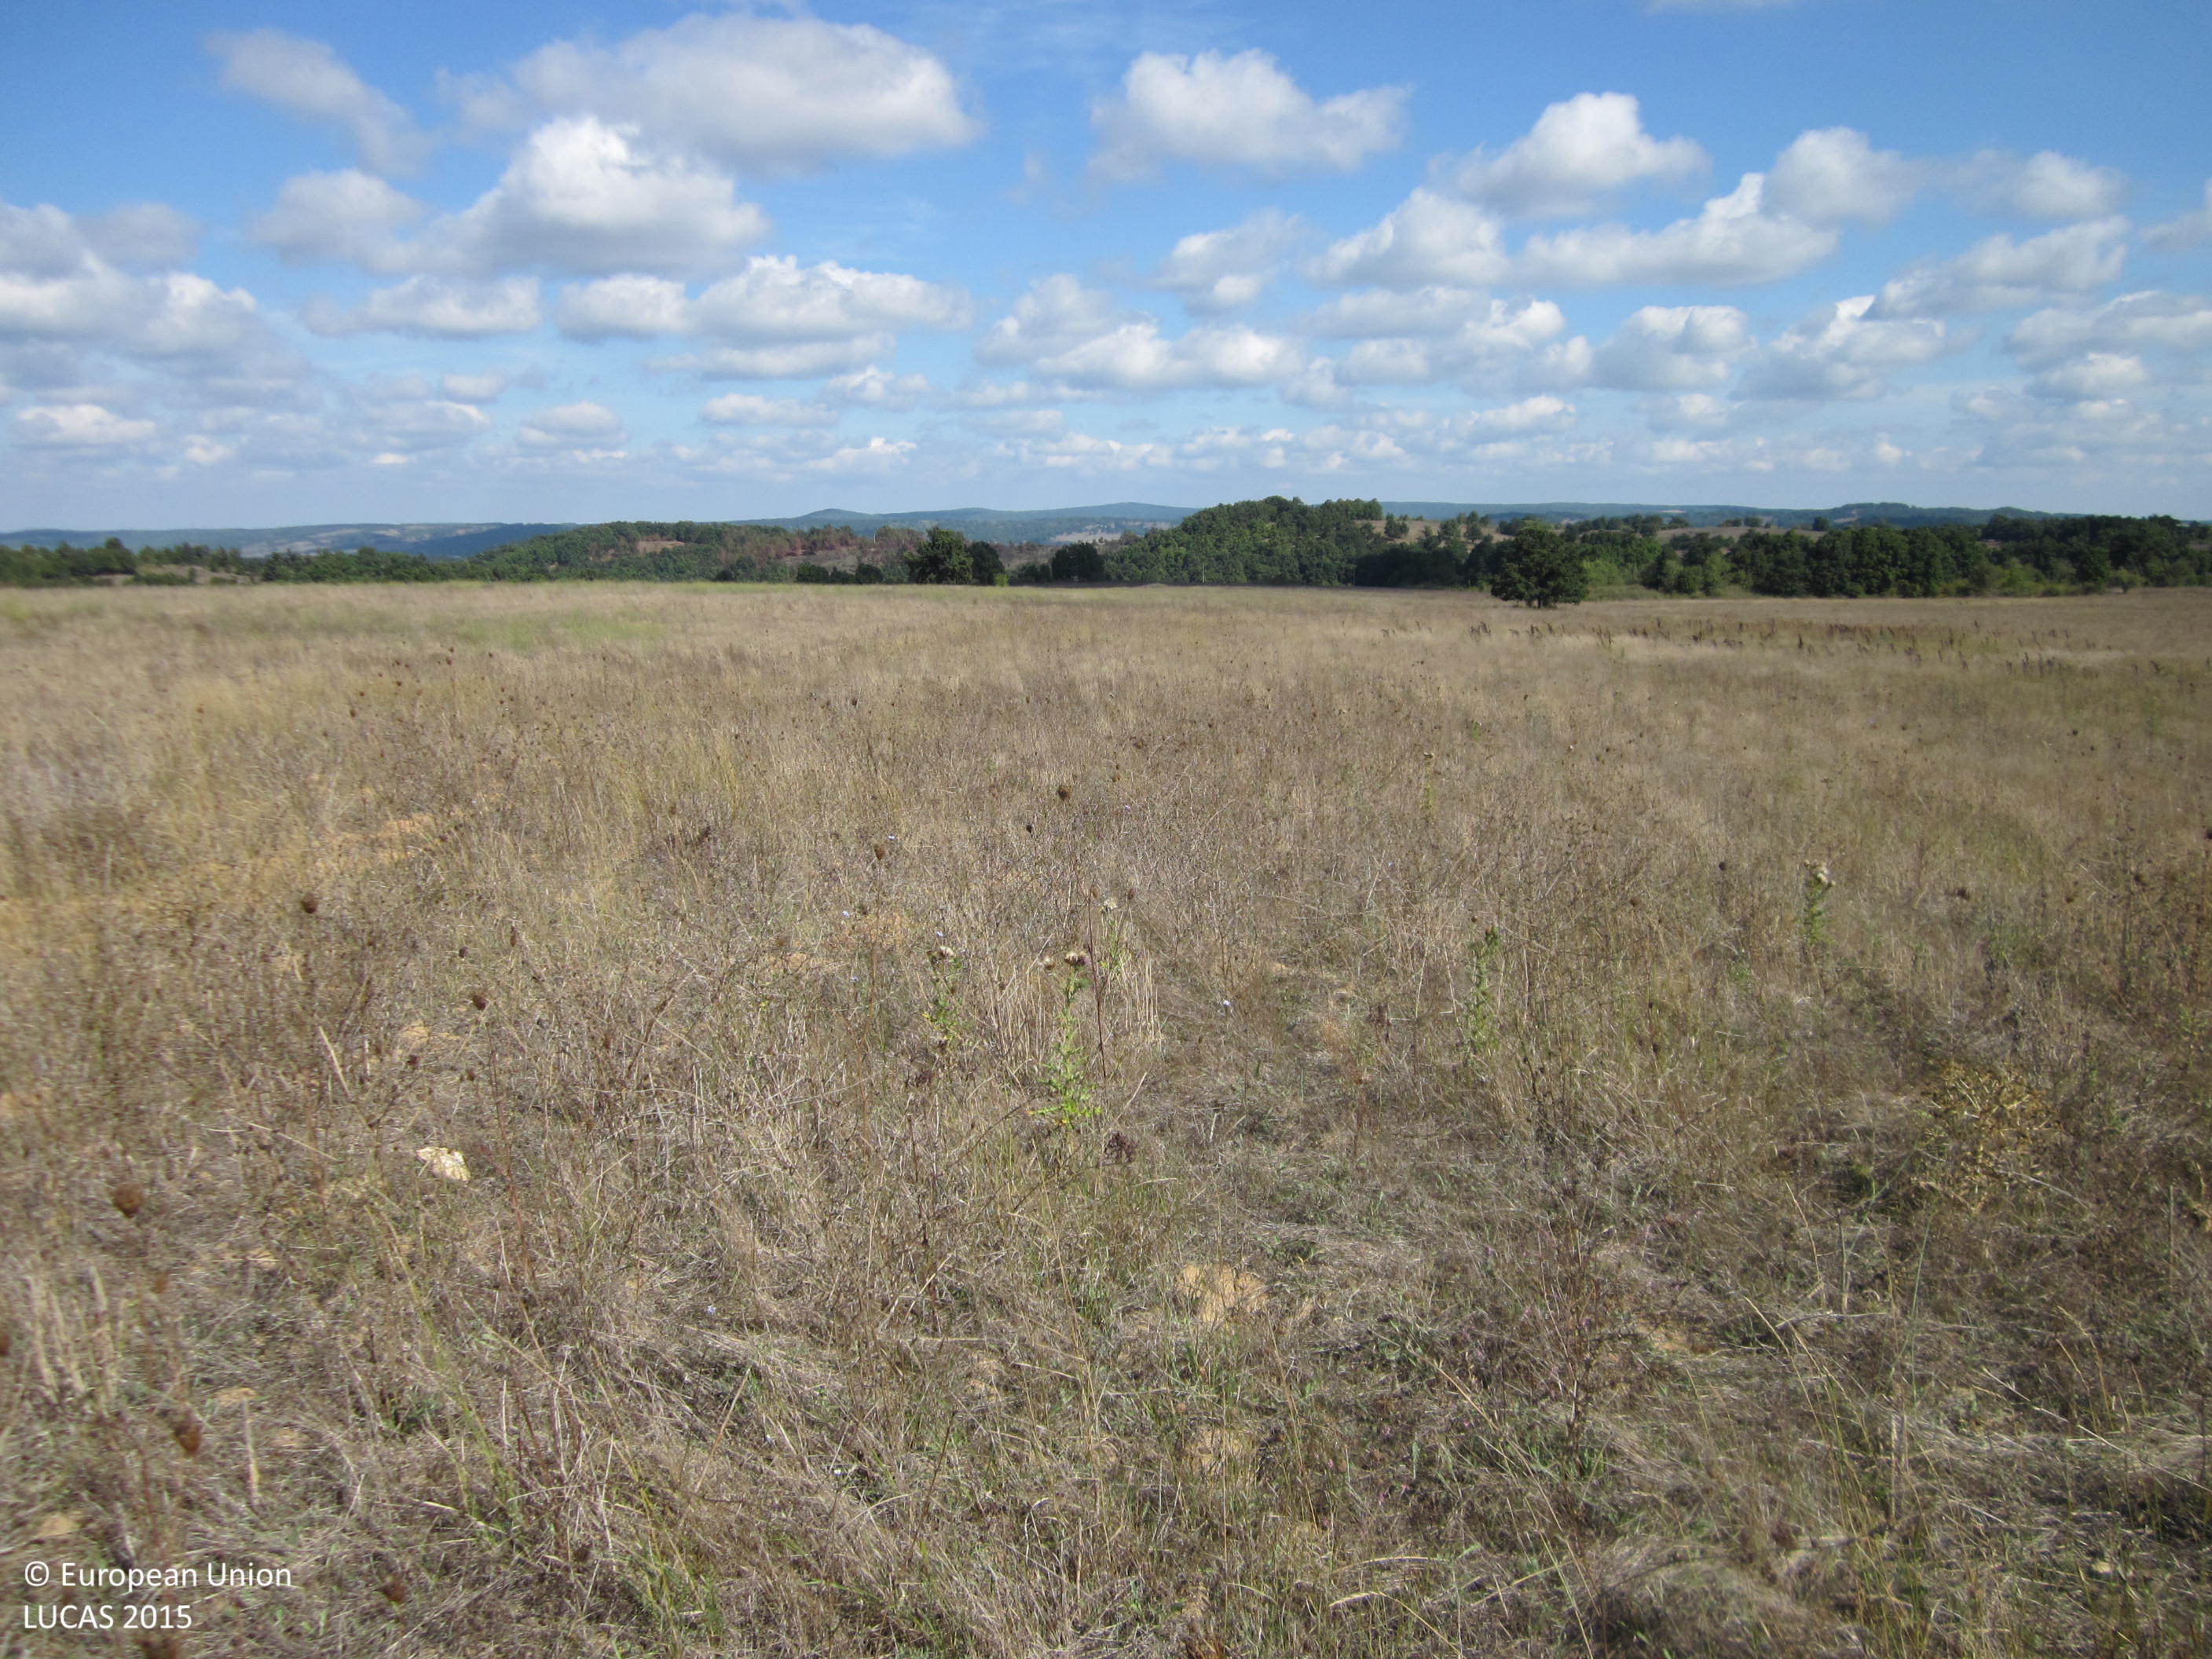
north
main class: Grassland
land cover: Spontaneously vegetated surfaces
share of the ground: > 75 %
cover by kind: herbaceous plants 95 %, unconsolidated bare surface 5 %
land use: Fallow land
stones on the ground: < 10 %
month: September
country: BG
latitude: 42.1444
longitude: 27.1032
